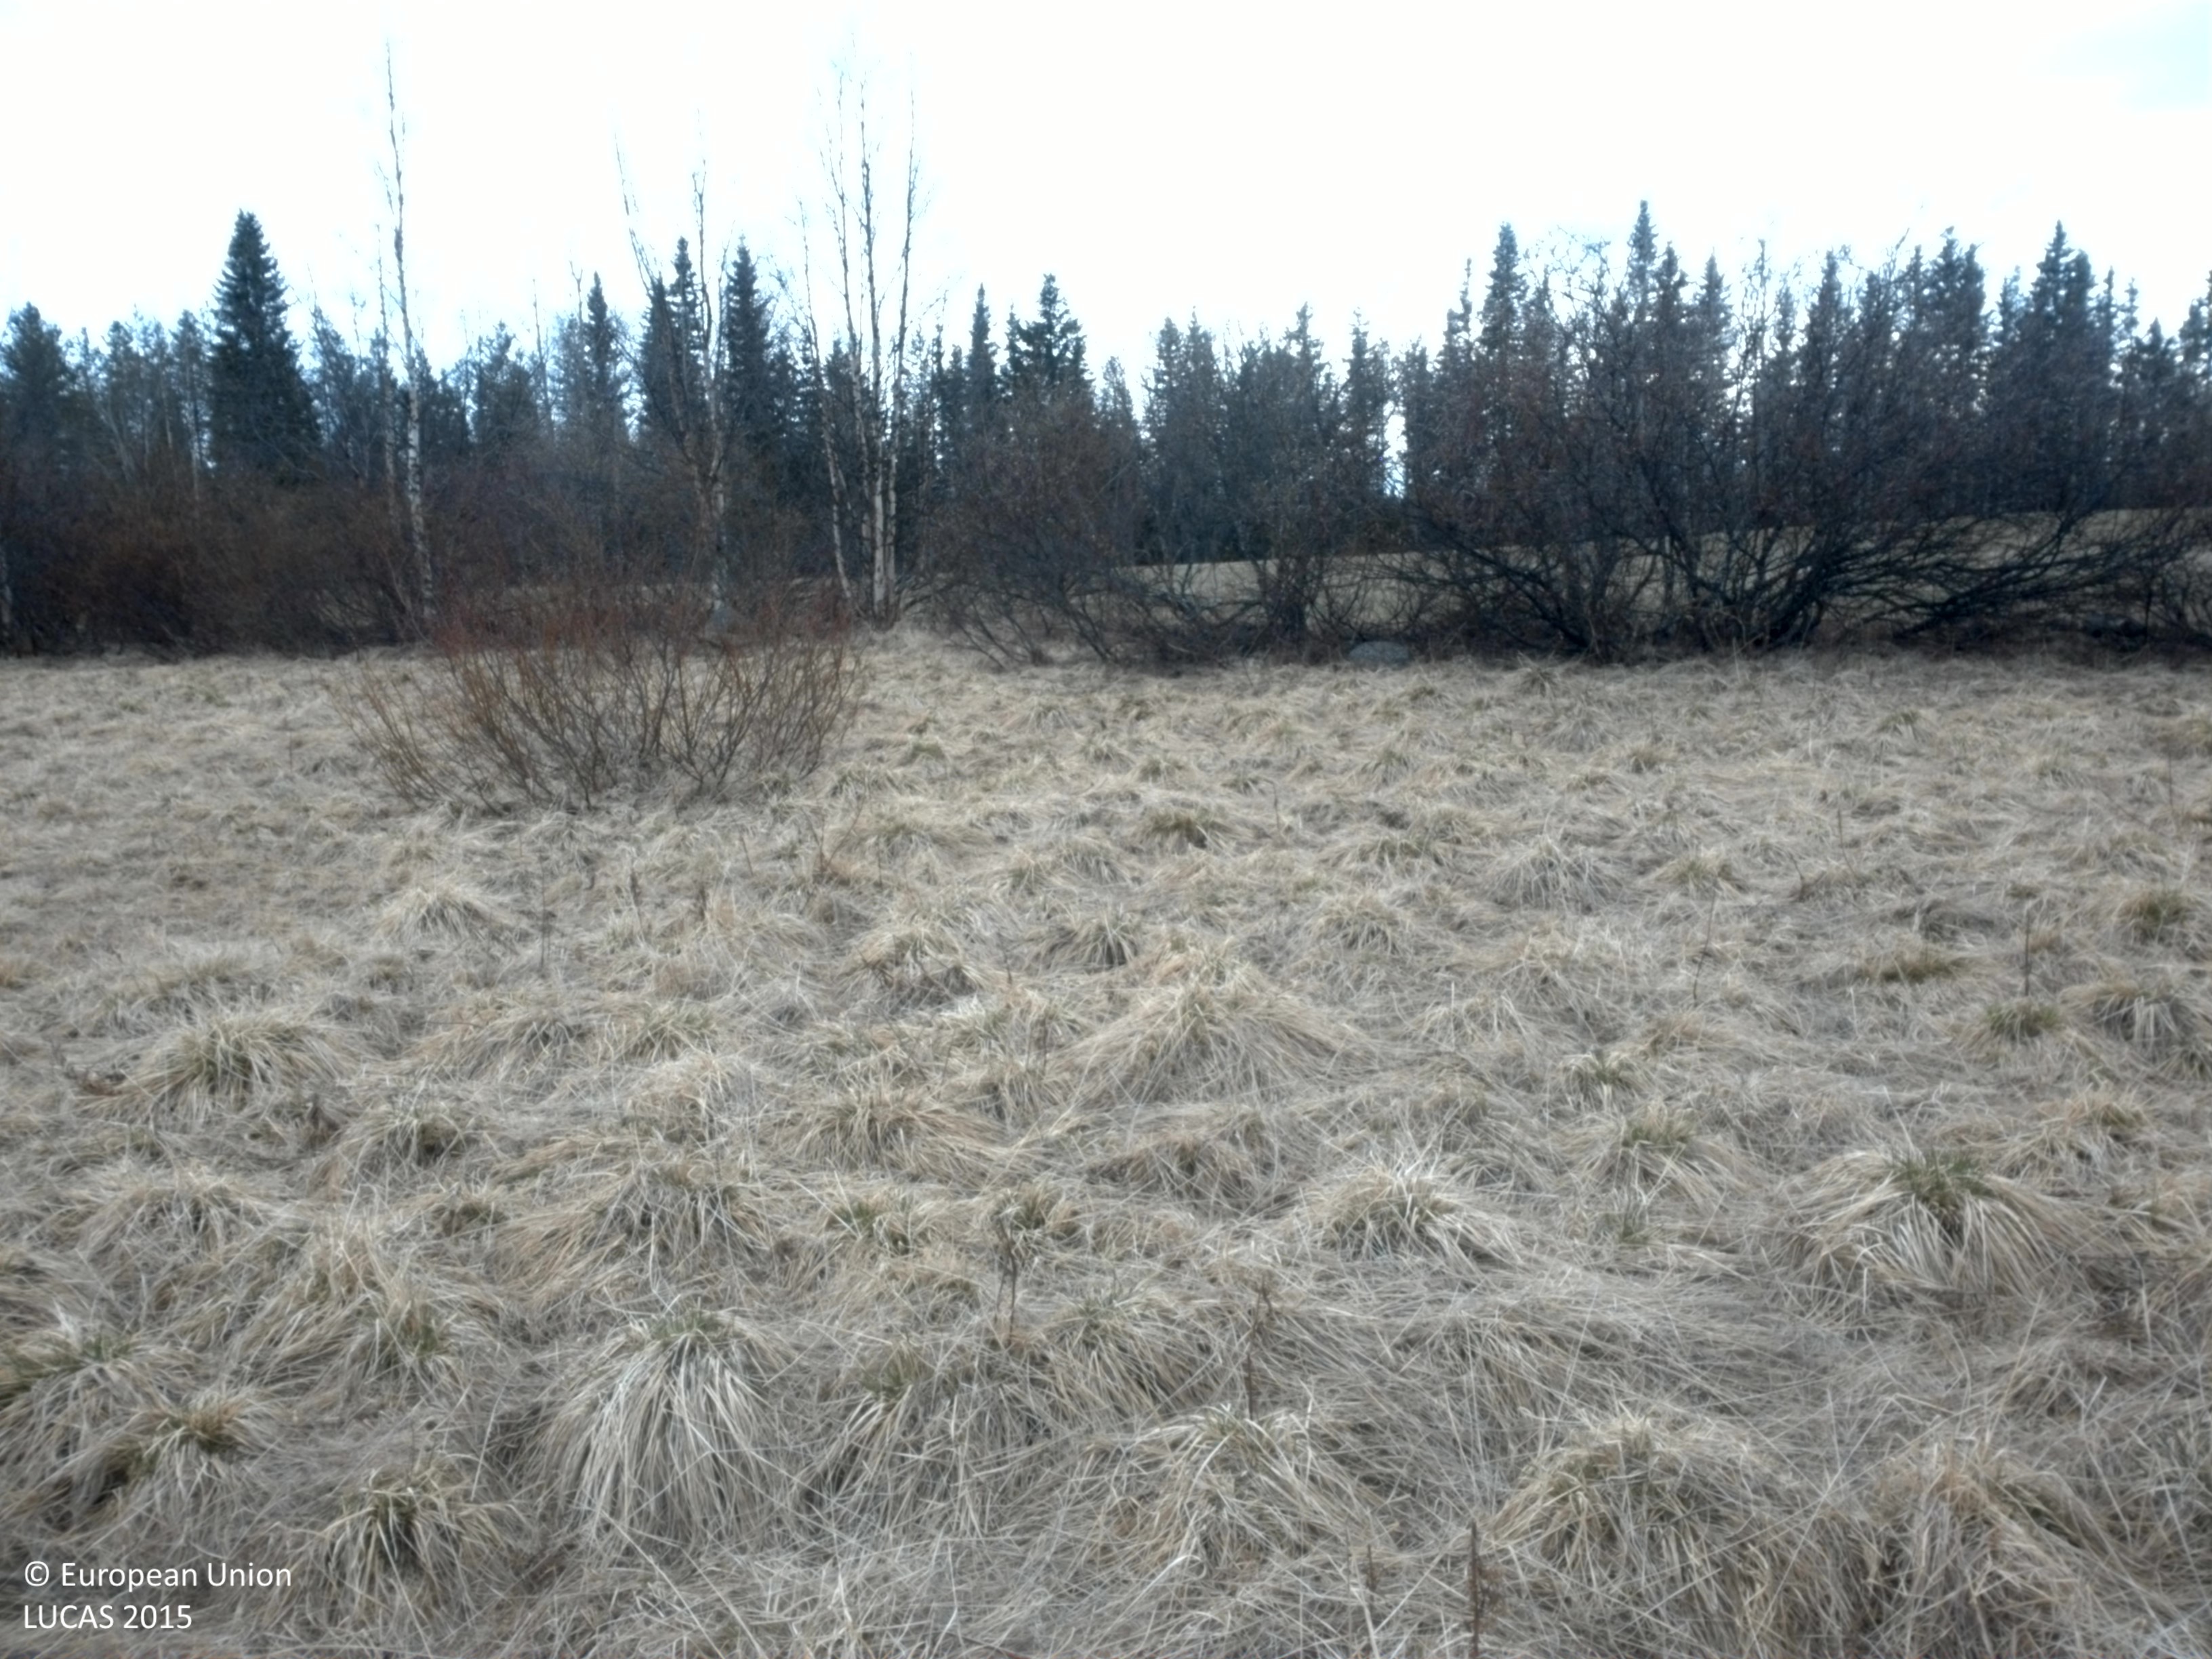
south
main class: Grassland
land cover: Grassland without tree/shrub cover
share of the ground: > 75 %
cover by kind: herbaceous plants 100 %
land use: Abandoned areas
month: May
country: SE
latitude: 64.2900
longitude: 18.2956
